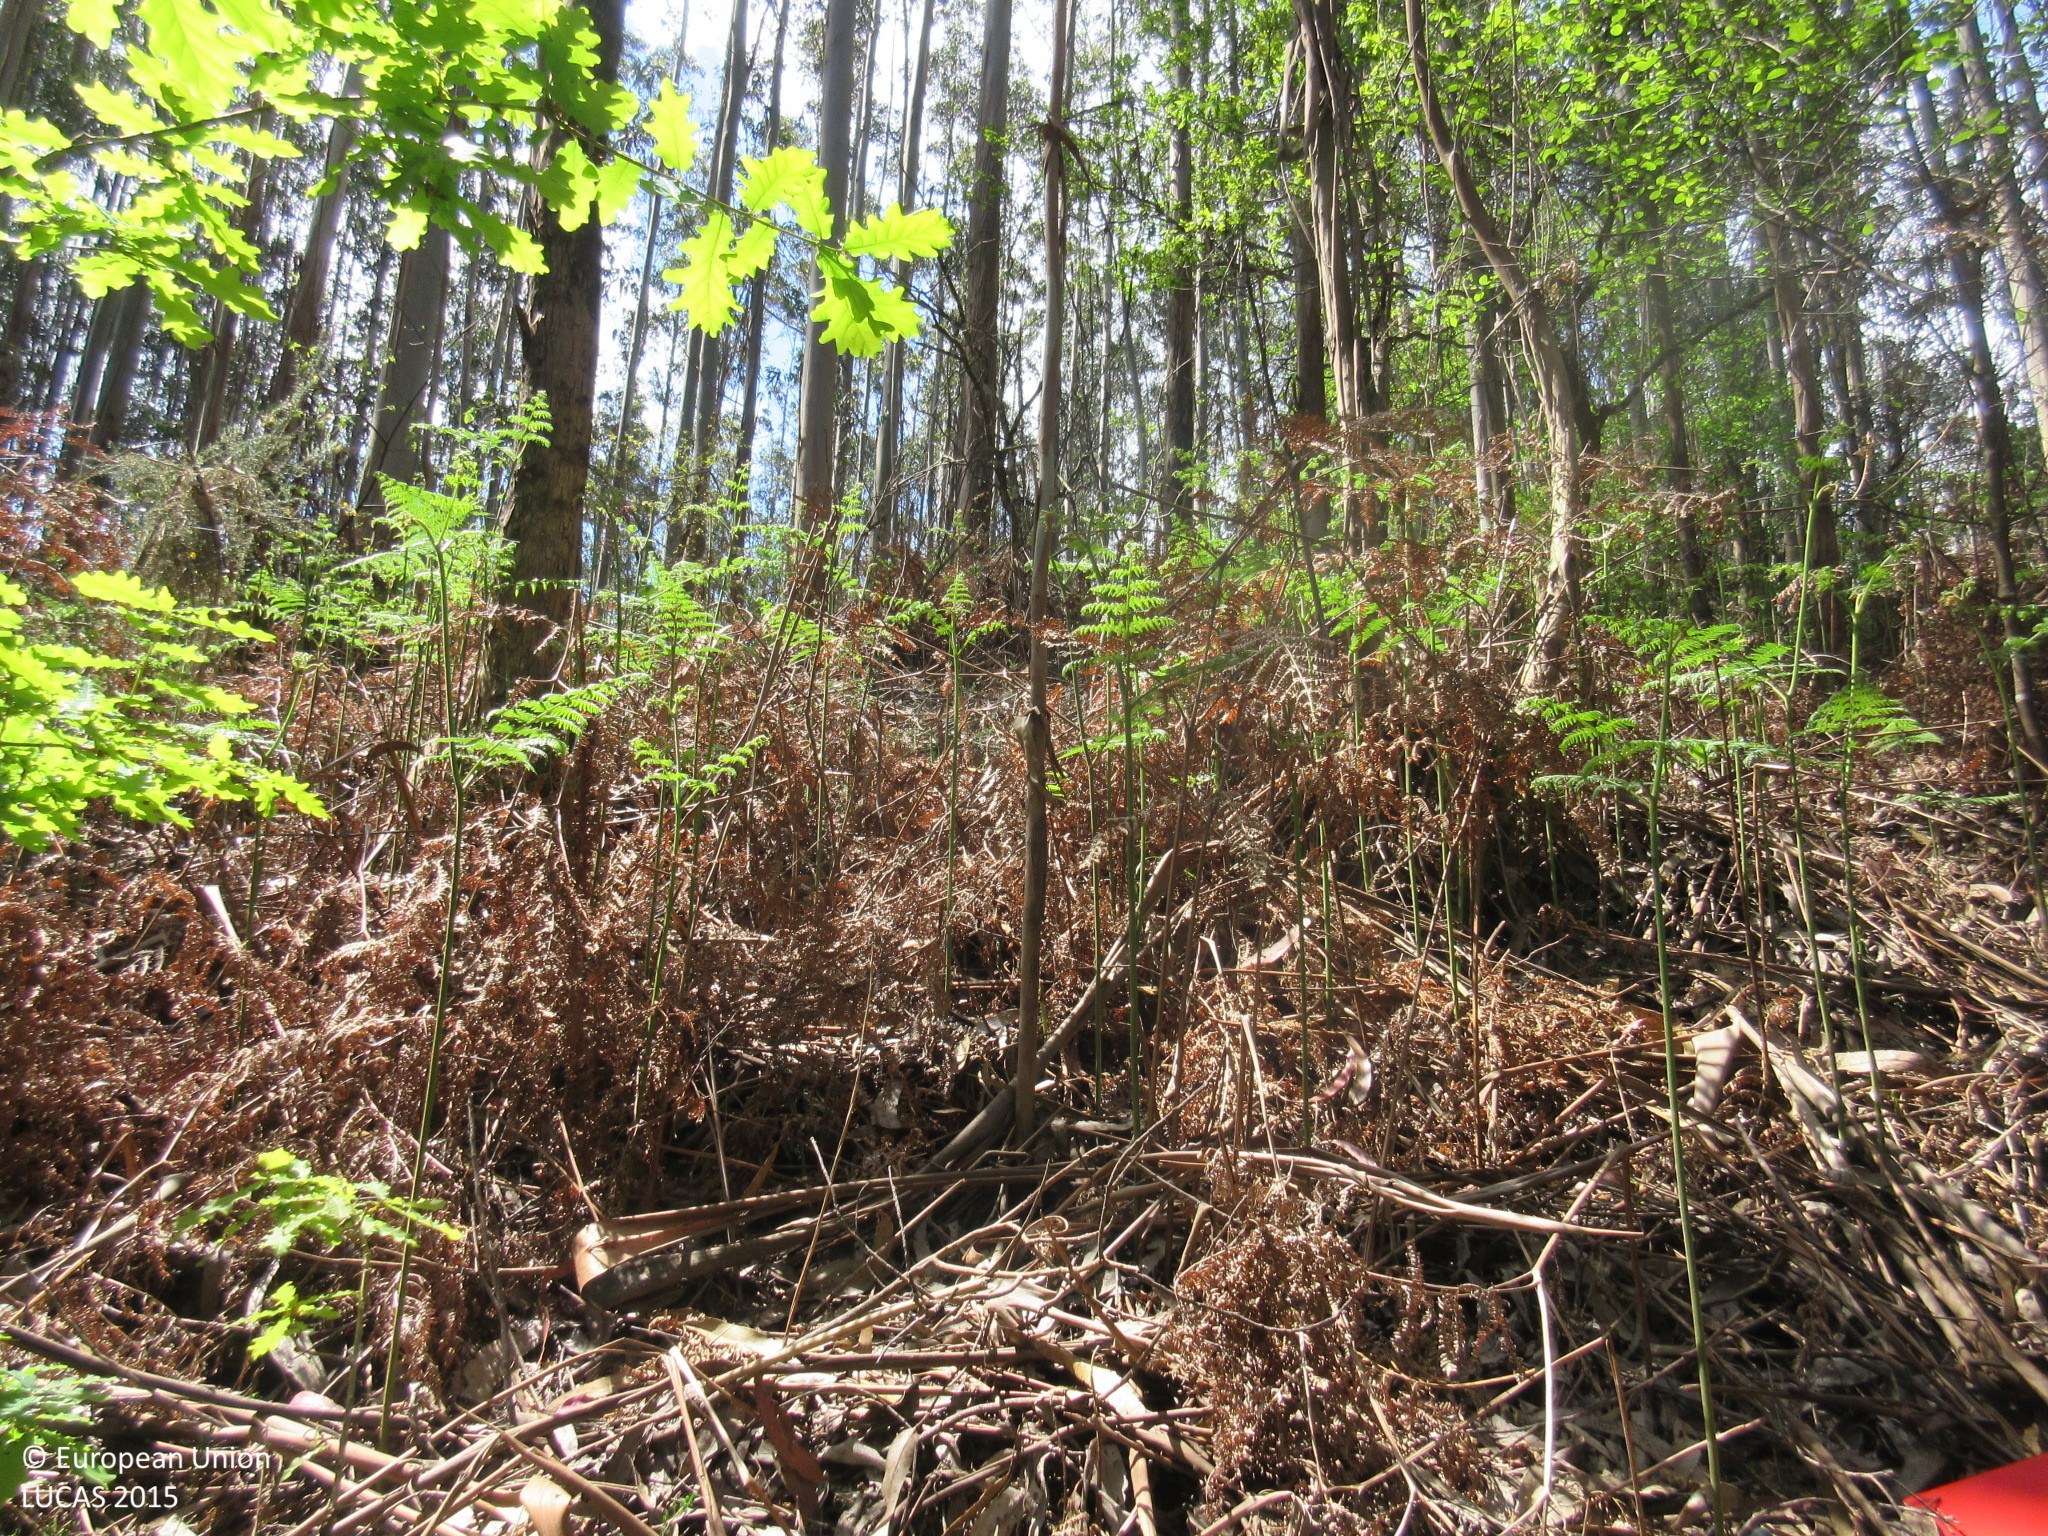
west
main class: Woodland
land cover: Broadleaved woodland
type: exotic forest
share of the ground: > 75 %
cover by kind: broadleaved forest trees 95 %, shrubs 5 %
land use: Forestry
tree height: > 5 m
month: April
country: ES
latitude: 43.5109
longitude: -7.0785
